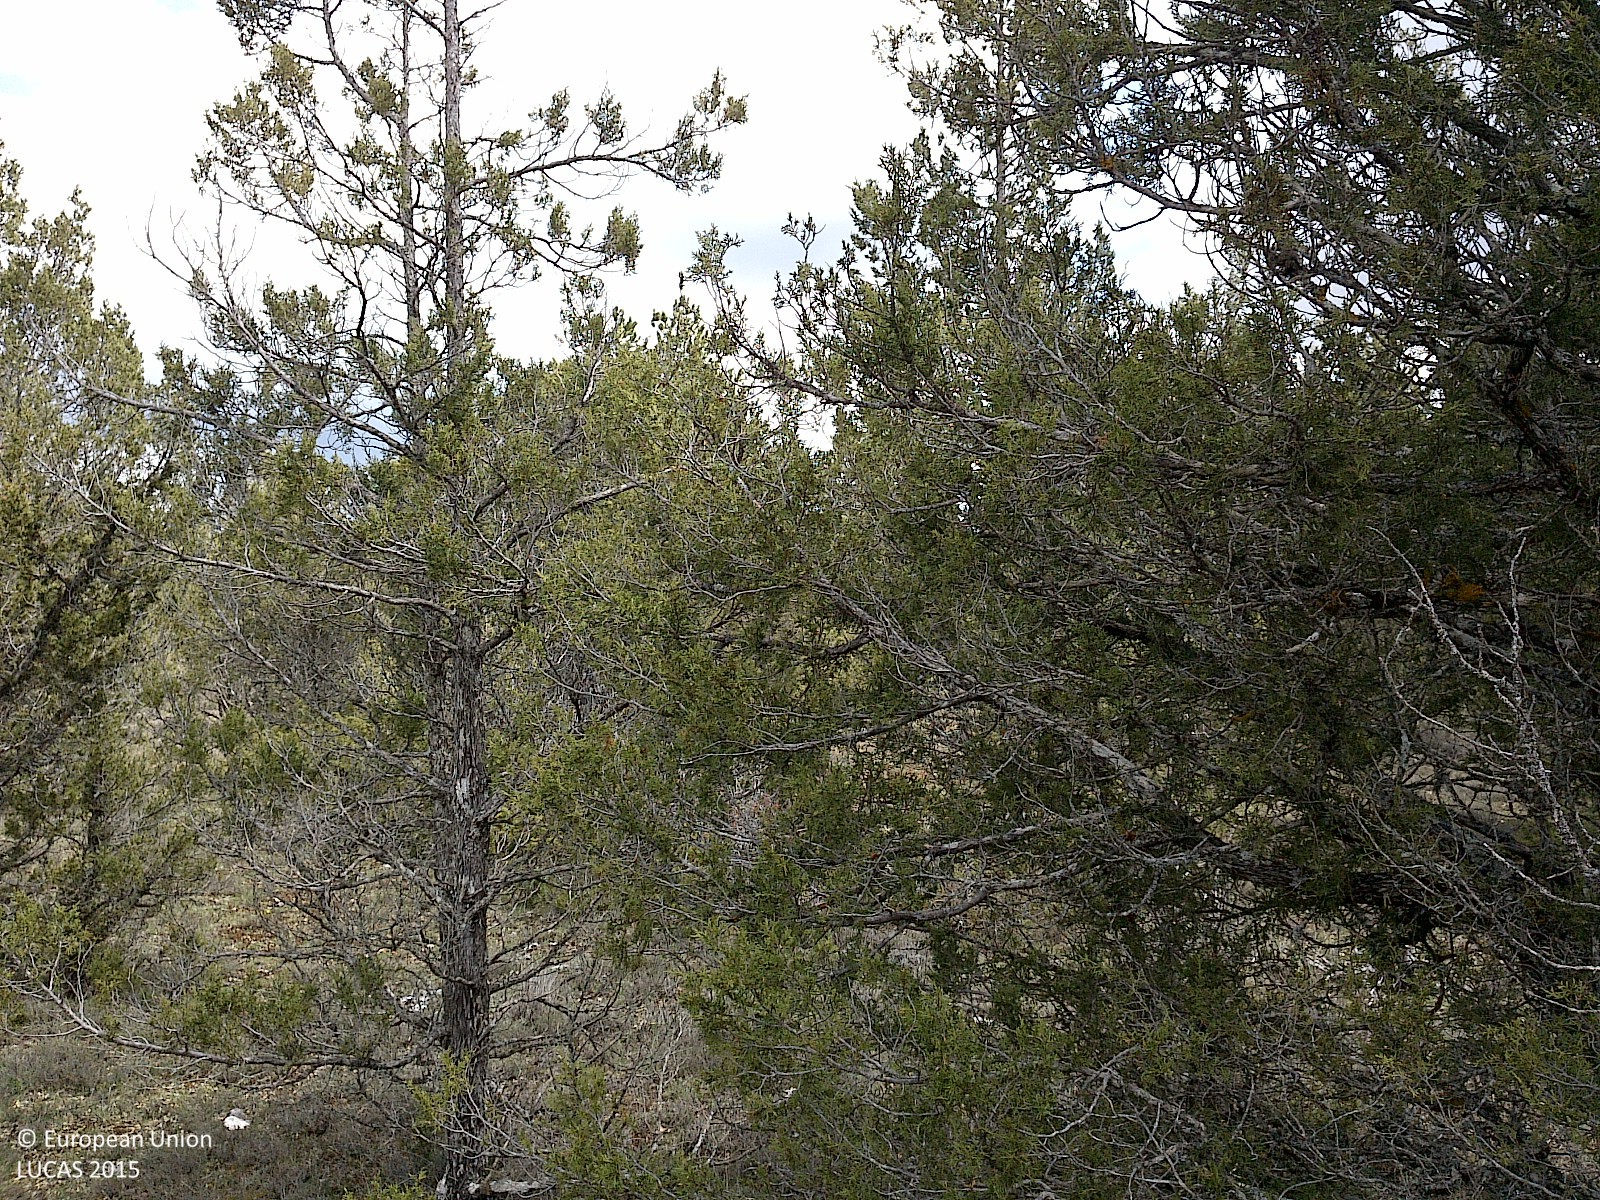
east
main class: Woodland
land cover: Other coniferous woodland
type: coniferous forest of the mediterranean region
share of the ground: 25 - 50 %
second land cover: Grassland without tree/shrub cover
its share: > 75 %
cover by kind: herbaceous plants 65 %, coniferous forest trees 35 %
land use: Forestry
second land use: Agriculture (excluding fallow land and kitchen gardens)
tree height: < 5 m
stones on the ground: 10 - 25 %
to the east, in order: Other coniferous woodland; Grassland without tree/shrub cover; Pine dominated coniferous woodland; Other coniferous woodland; Tracks; Other coniferous woodland; Pine dominated coniferous woodland; Tracks; Pine dominated coniferous woodland
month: April
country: ES
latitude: 41.7646
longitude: -2.8043
